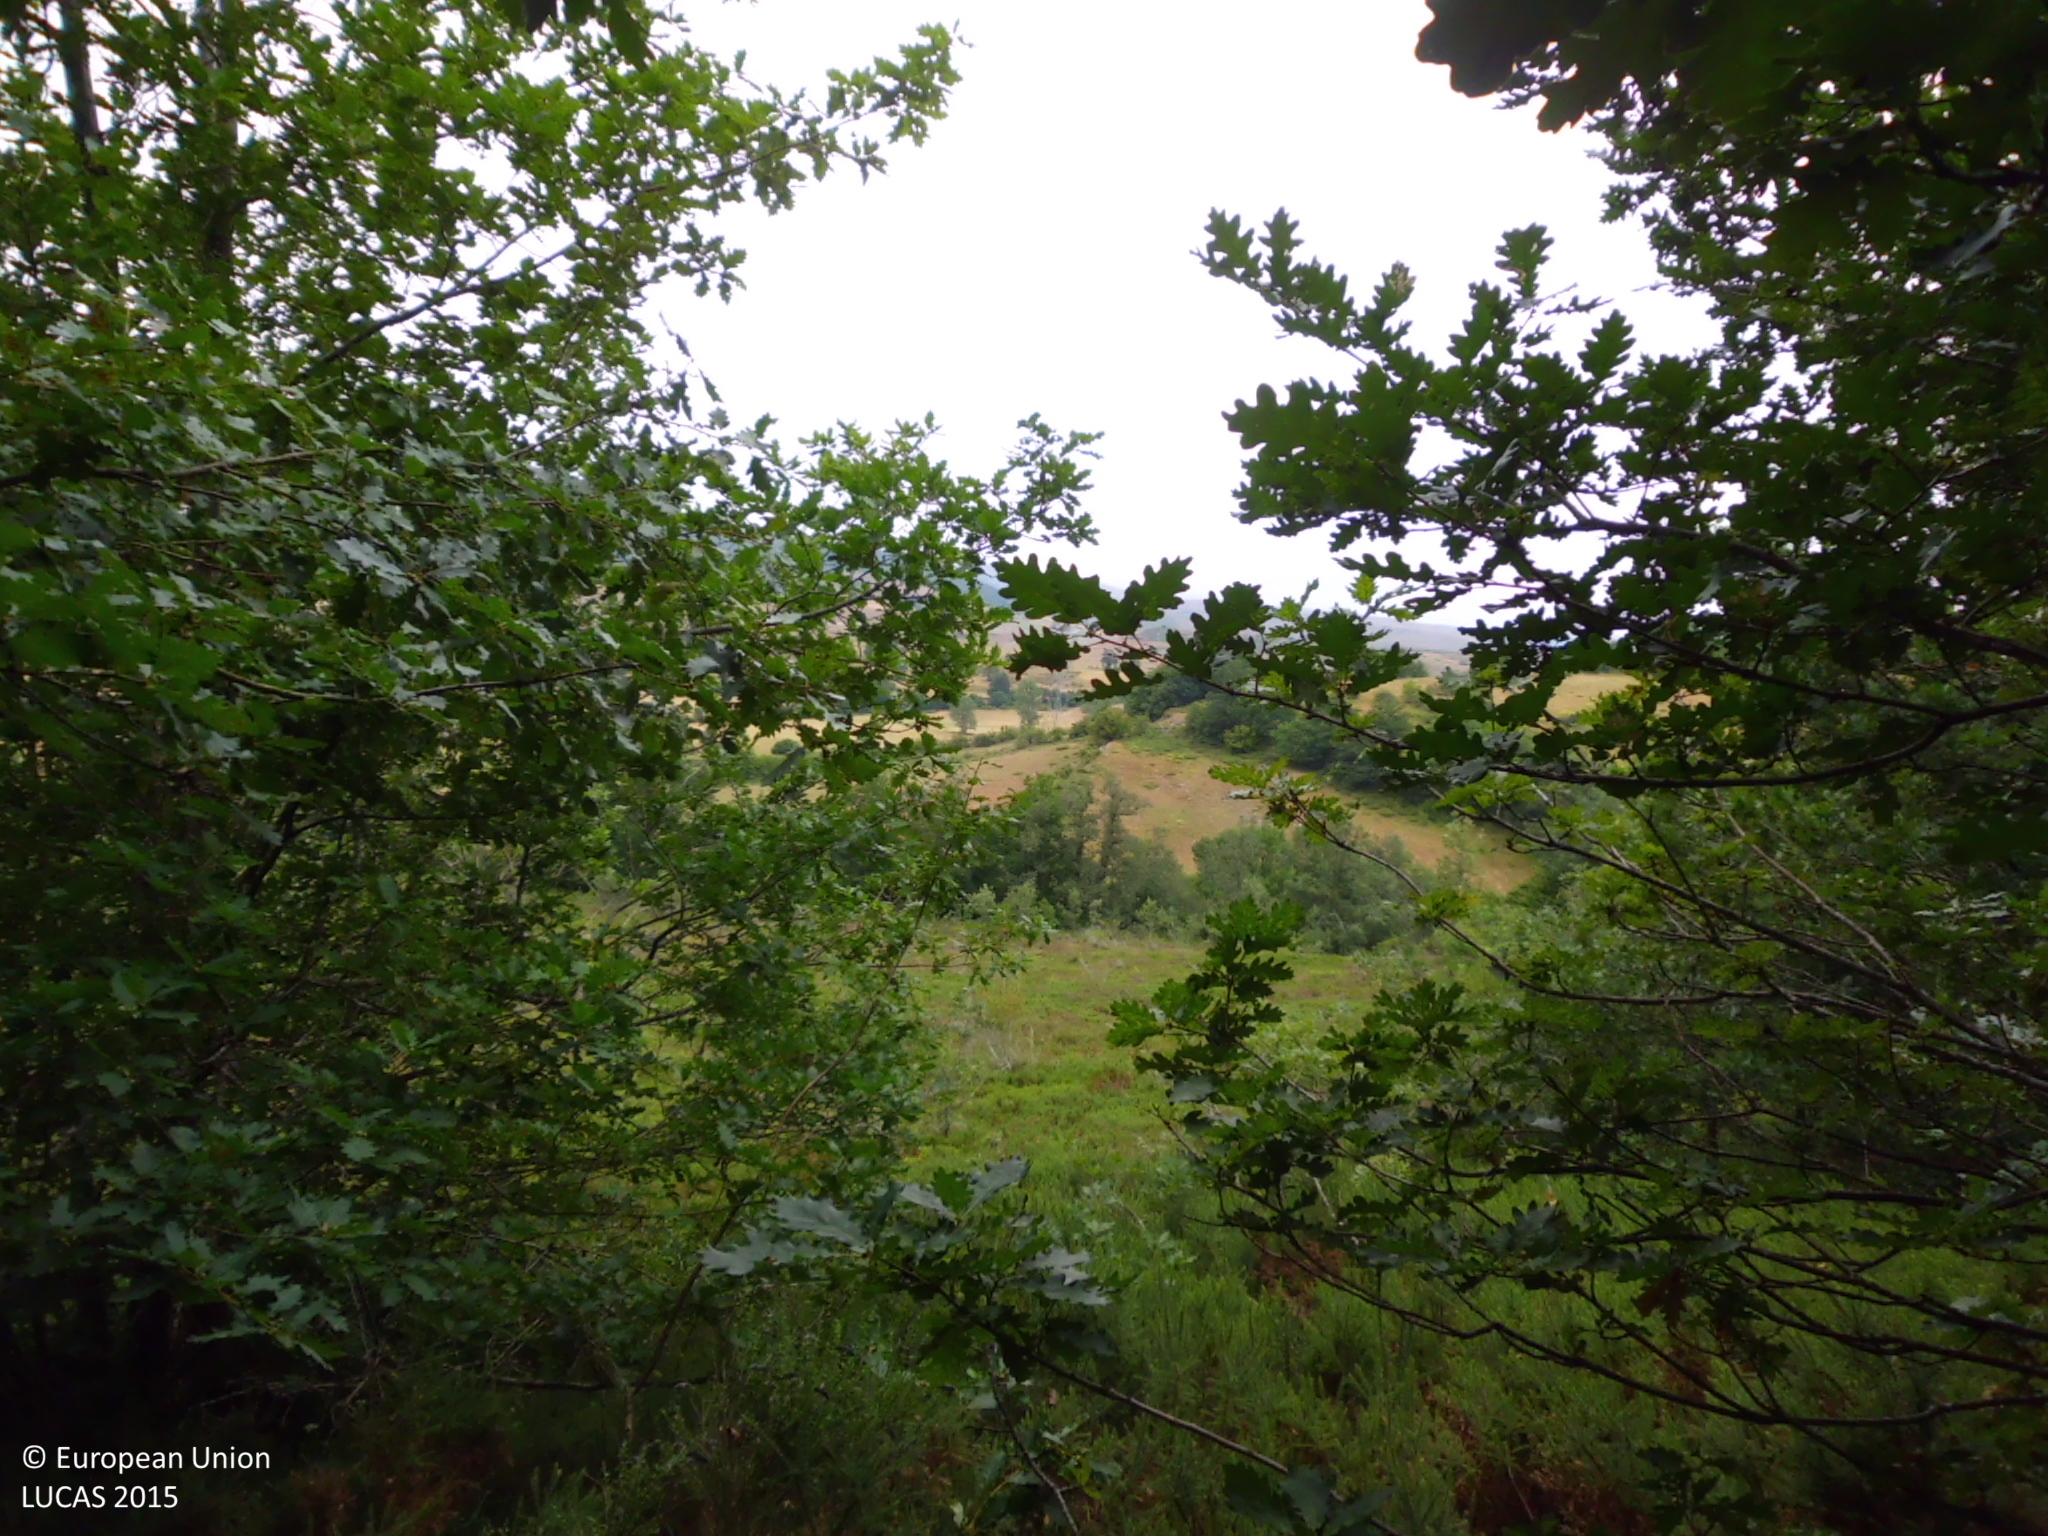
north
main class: Woodland
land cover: Broadleaved woodland
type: acidophilous oak and oak-birch forest
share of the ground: > 75 %
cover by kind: broadleaved forest trees 95 %, shrubs 5 %
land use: Semi-natural and natural areas not in use
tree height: > 5 m
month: July
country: ES
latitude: 42.8648
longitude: -4.1369
